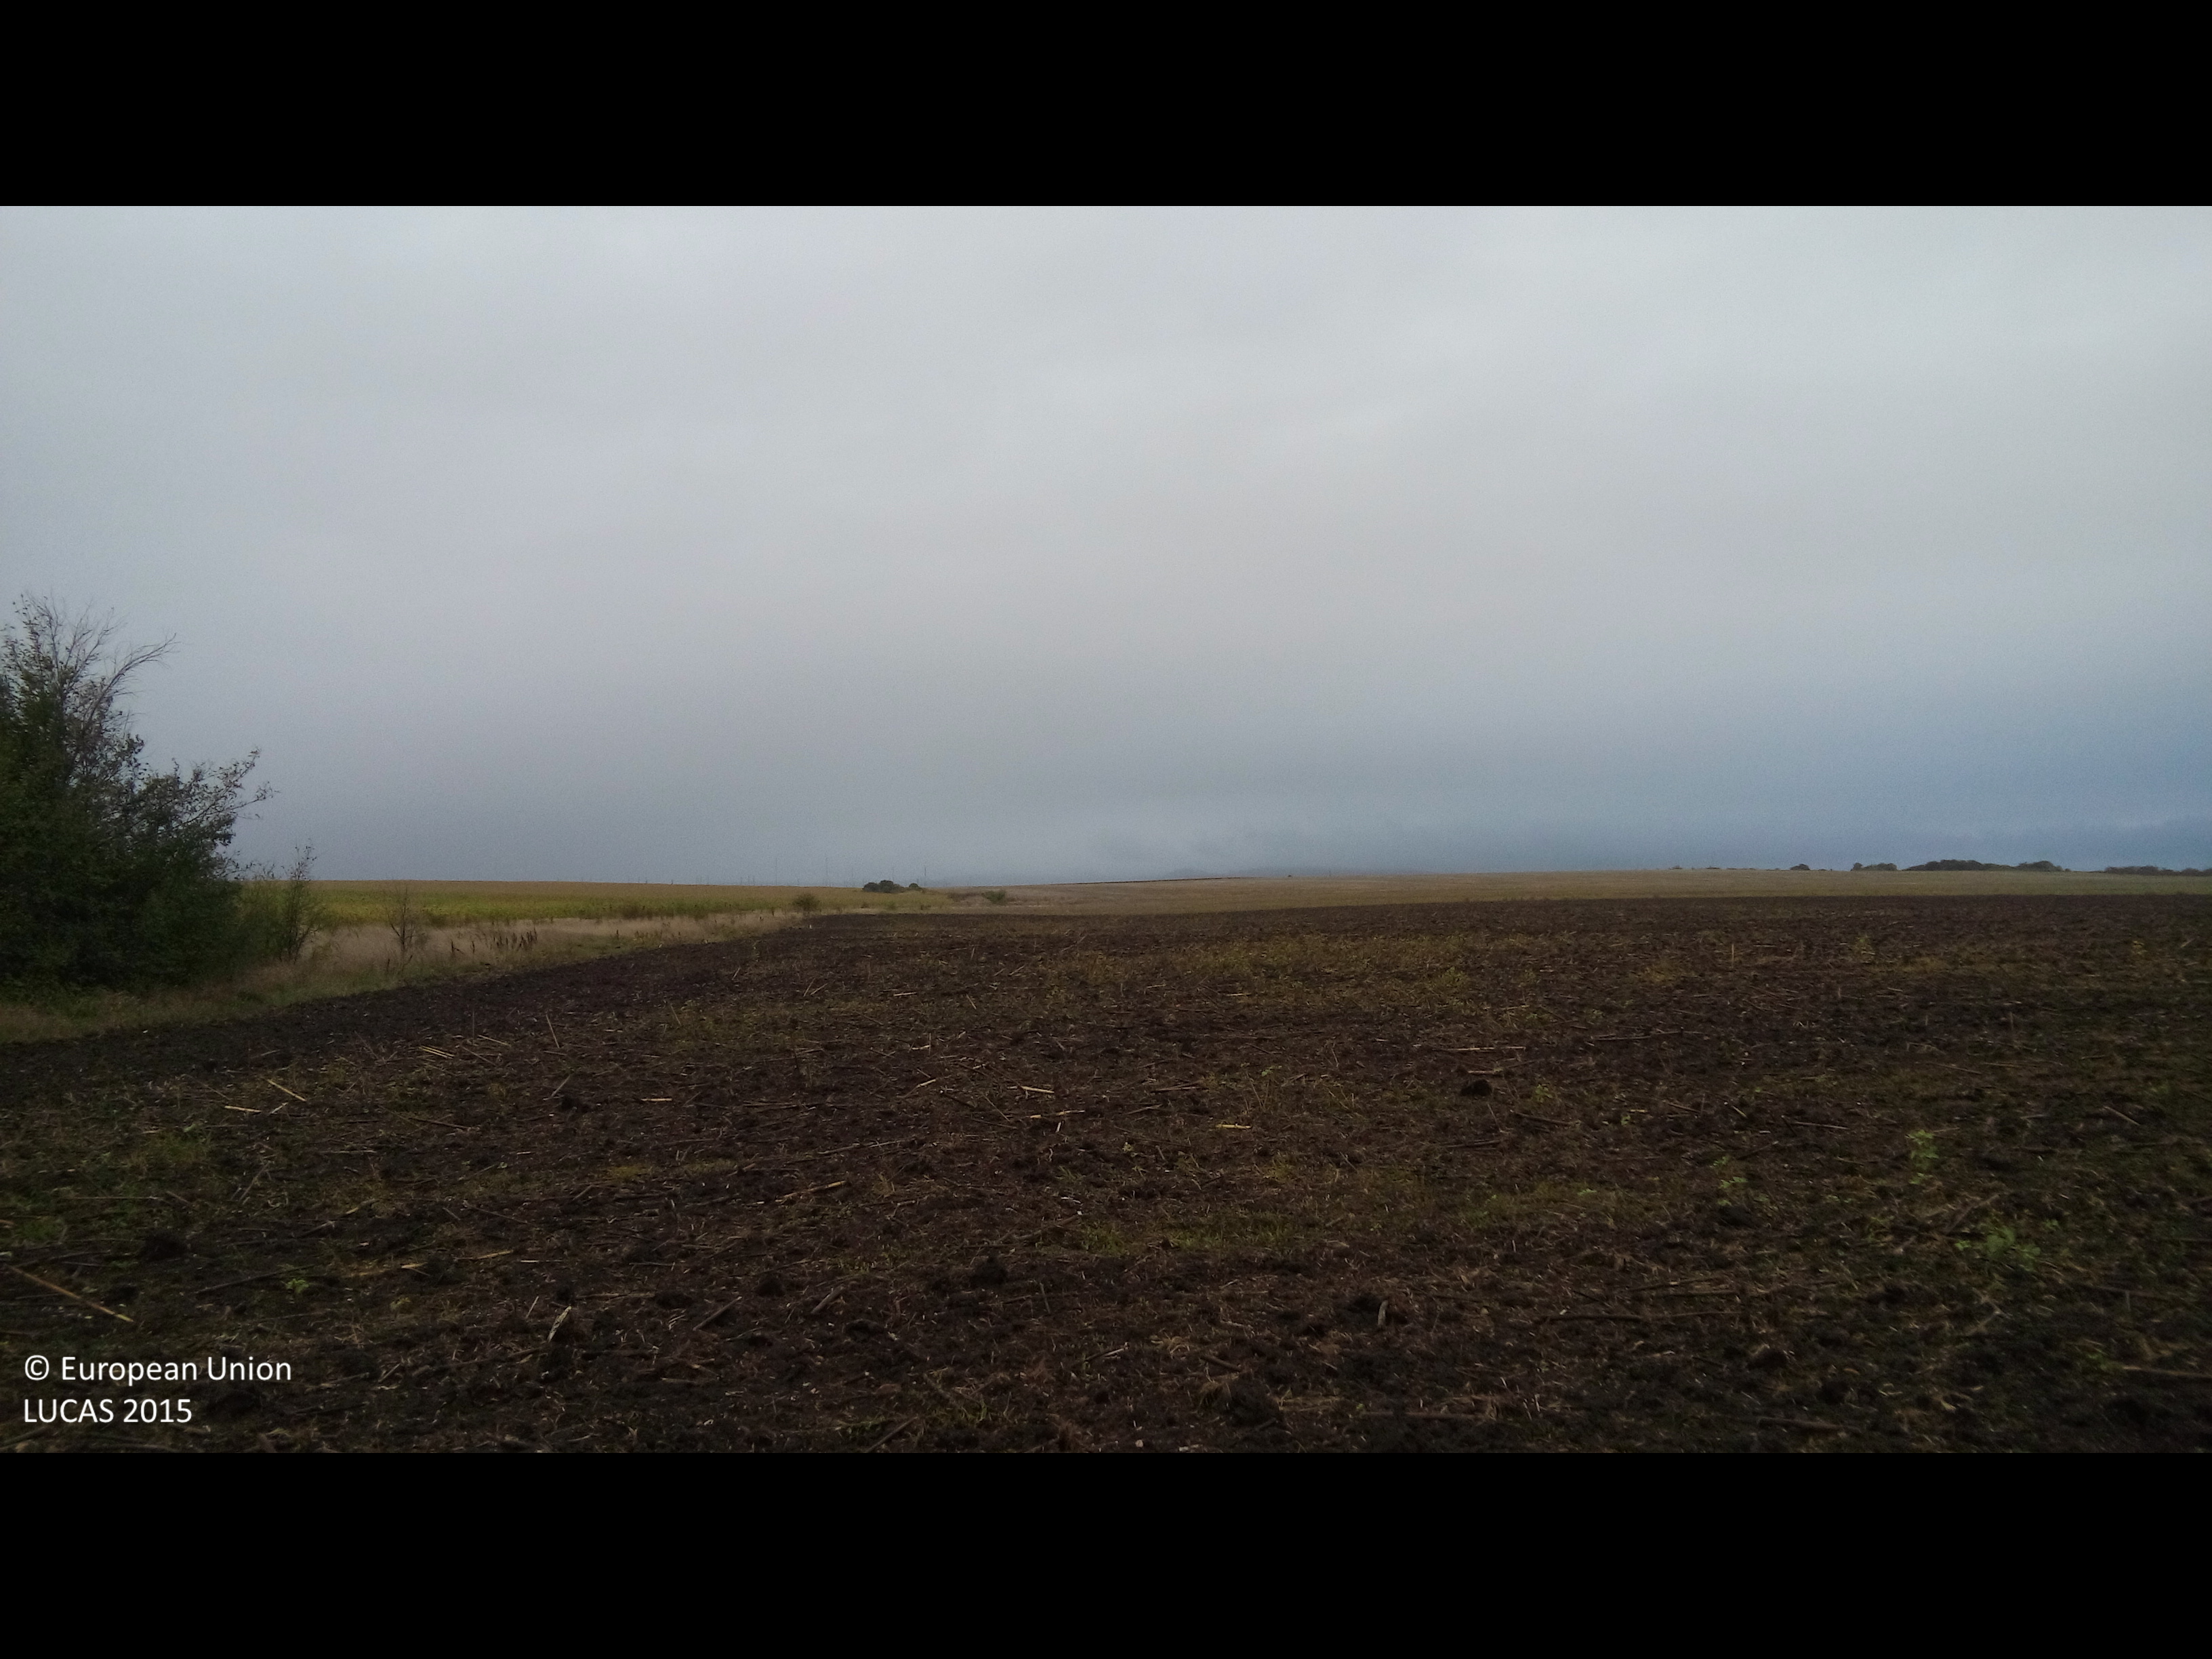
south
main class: Cropland
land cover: Sunflower
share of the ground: 10 - 25 %
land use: Agriculture (excluding fallow land and kitchen gardens)
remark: Harvested field
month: September
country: BG
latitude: 42.7376
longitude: 23.1882
